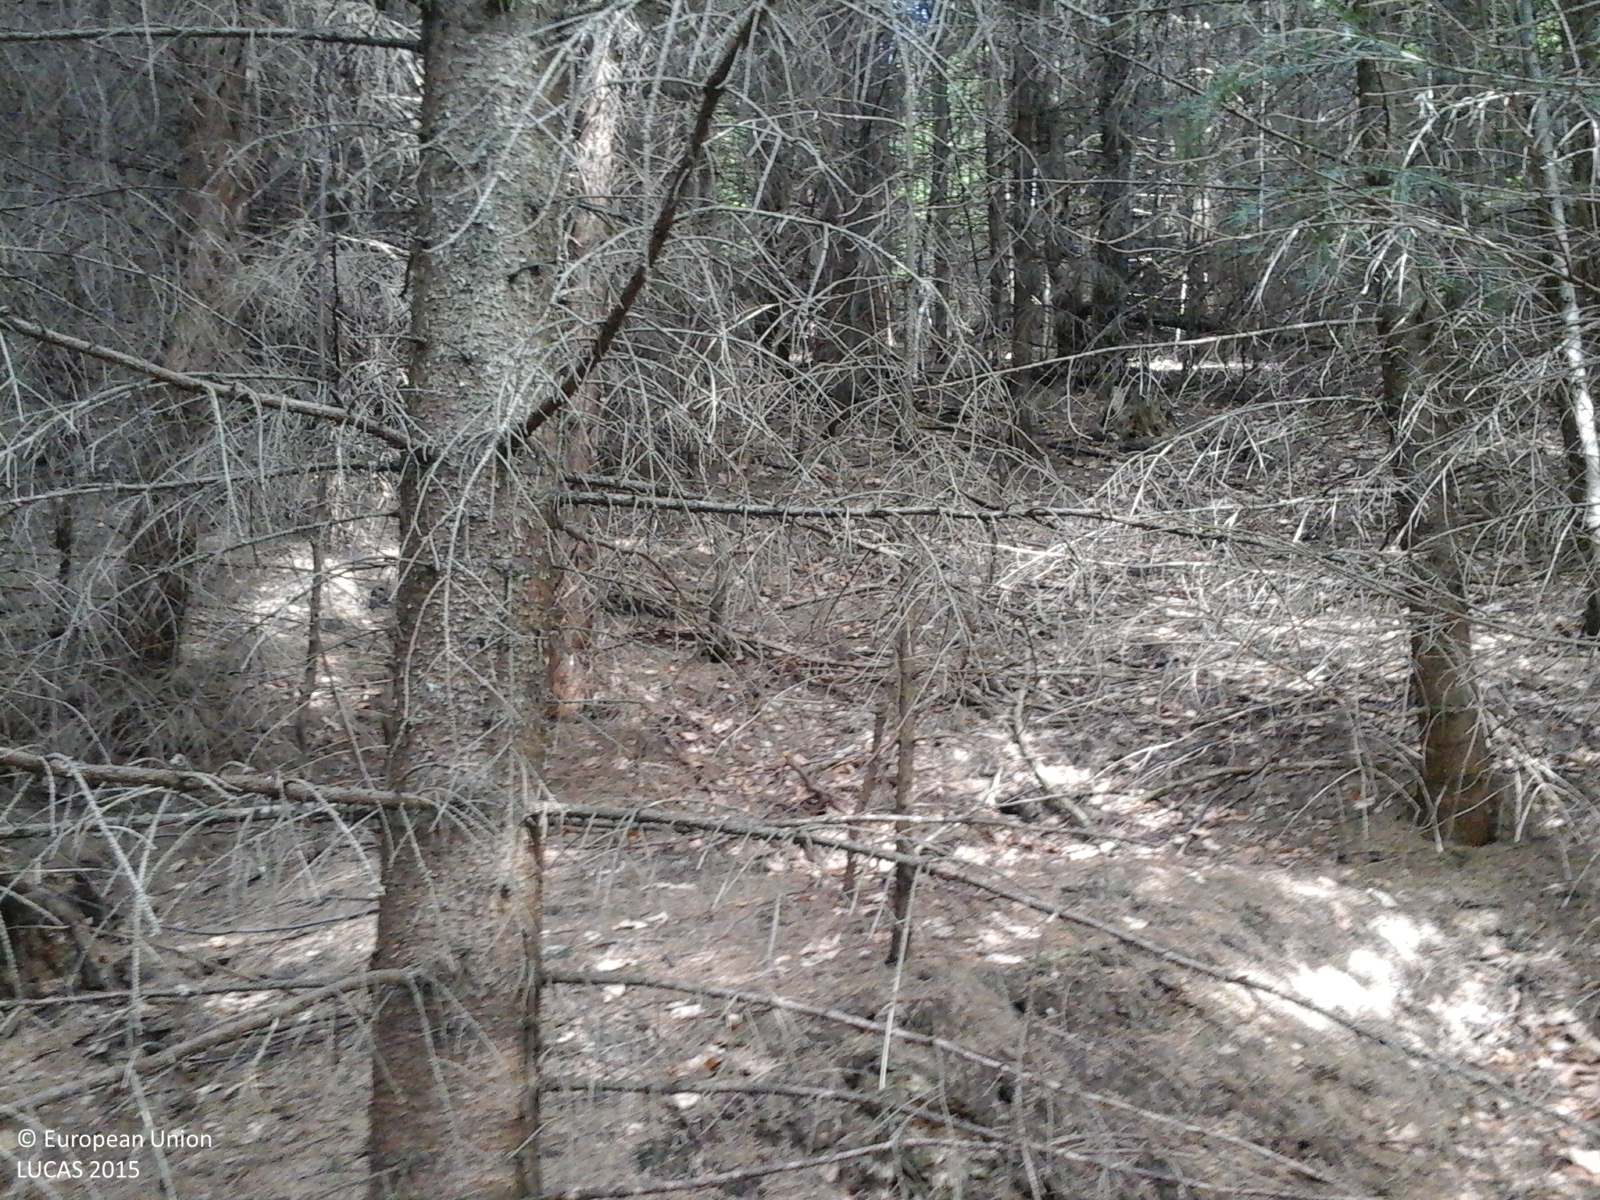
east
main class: Woodland
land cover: Spruce dominated mixed woodland
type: alpine coniferous forest
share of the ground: > 75 %
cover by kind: coniferous forest trees 75 %, broadleaved forest trees 25 %
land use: Forestry
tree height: > 5 m
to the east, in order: Spruce dominated mixed woodland
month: May
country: RO
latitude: 45.7462
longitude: 26.3319
